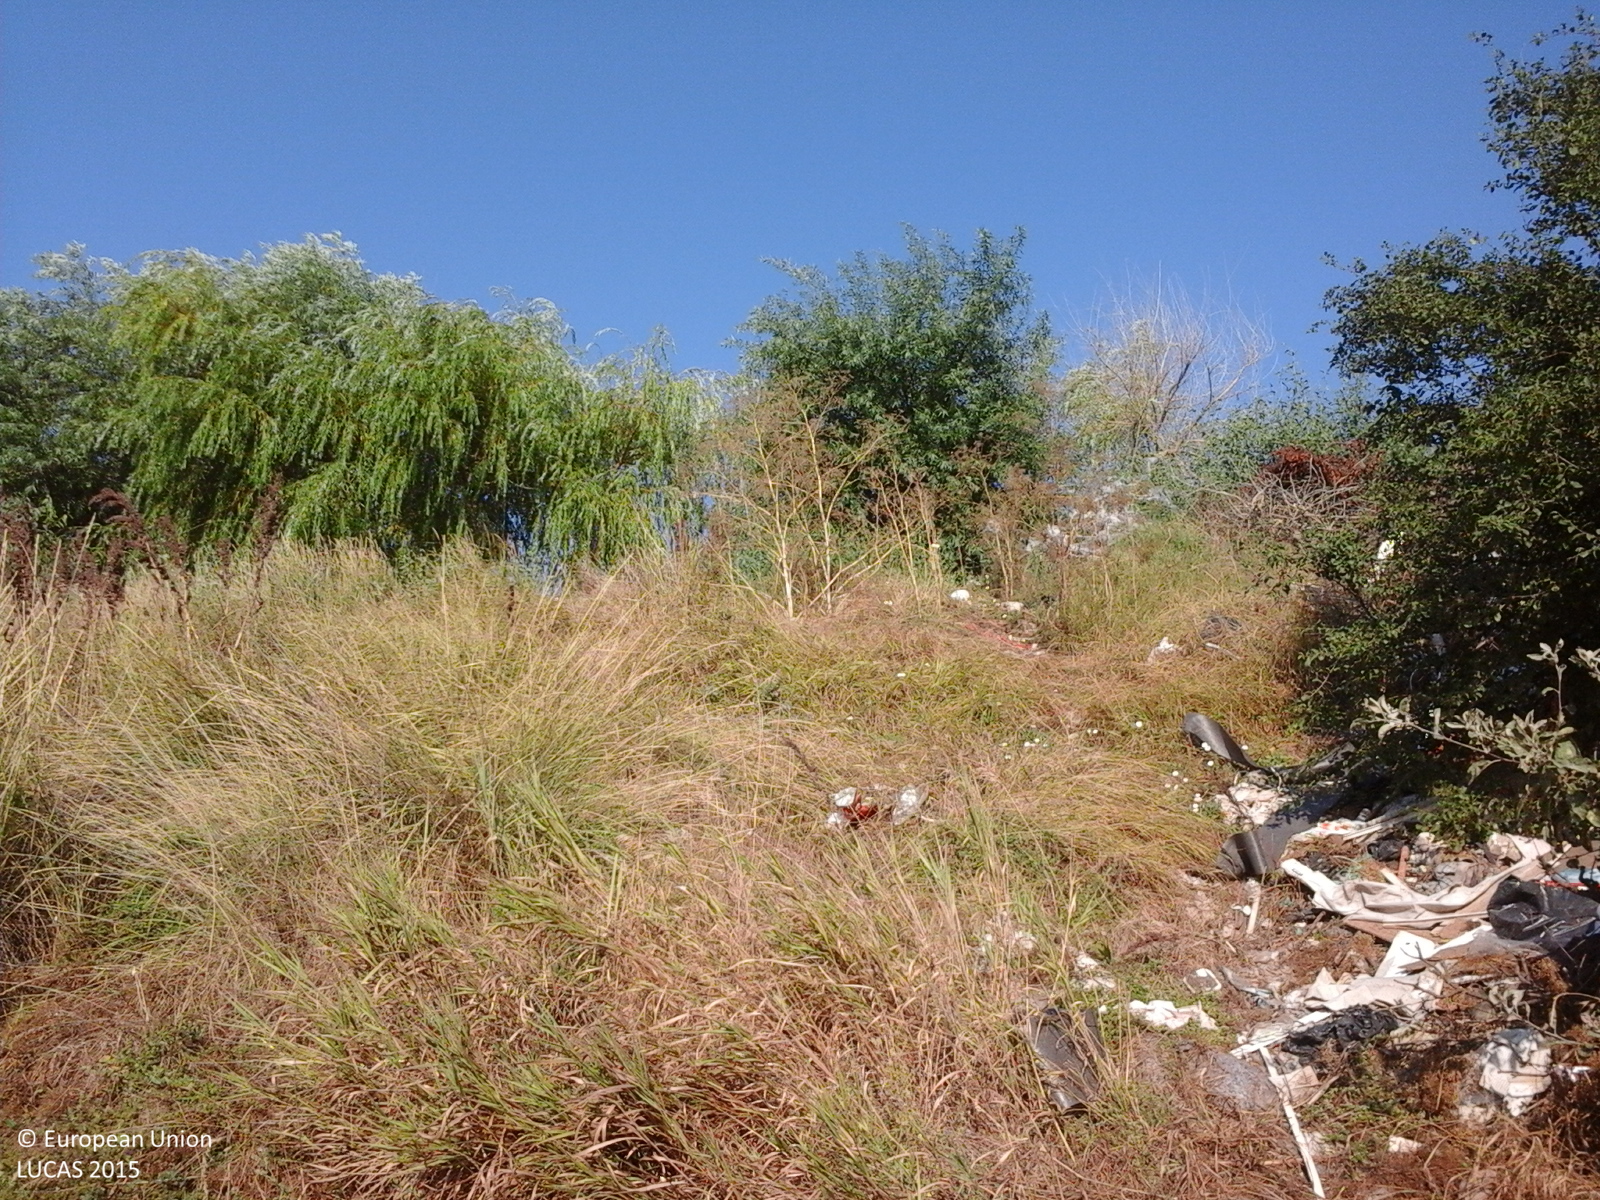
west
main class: Grassland
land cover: Spontaneously vegetated surfaces
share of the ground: > 75 %
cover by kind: herbaceous plants 100 %
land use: Semi-natural and natural areas not in use
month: August
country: RO
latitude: 44.1923
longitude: 28.6543
